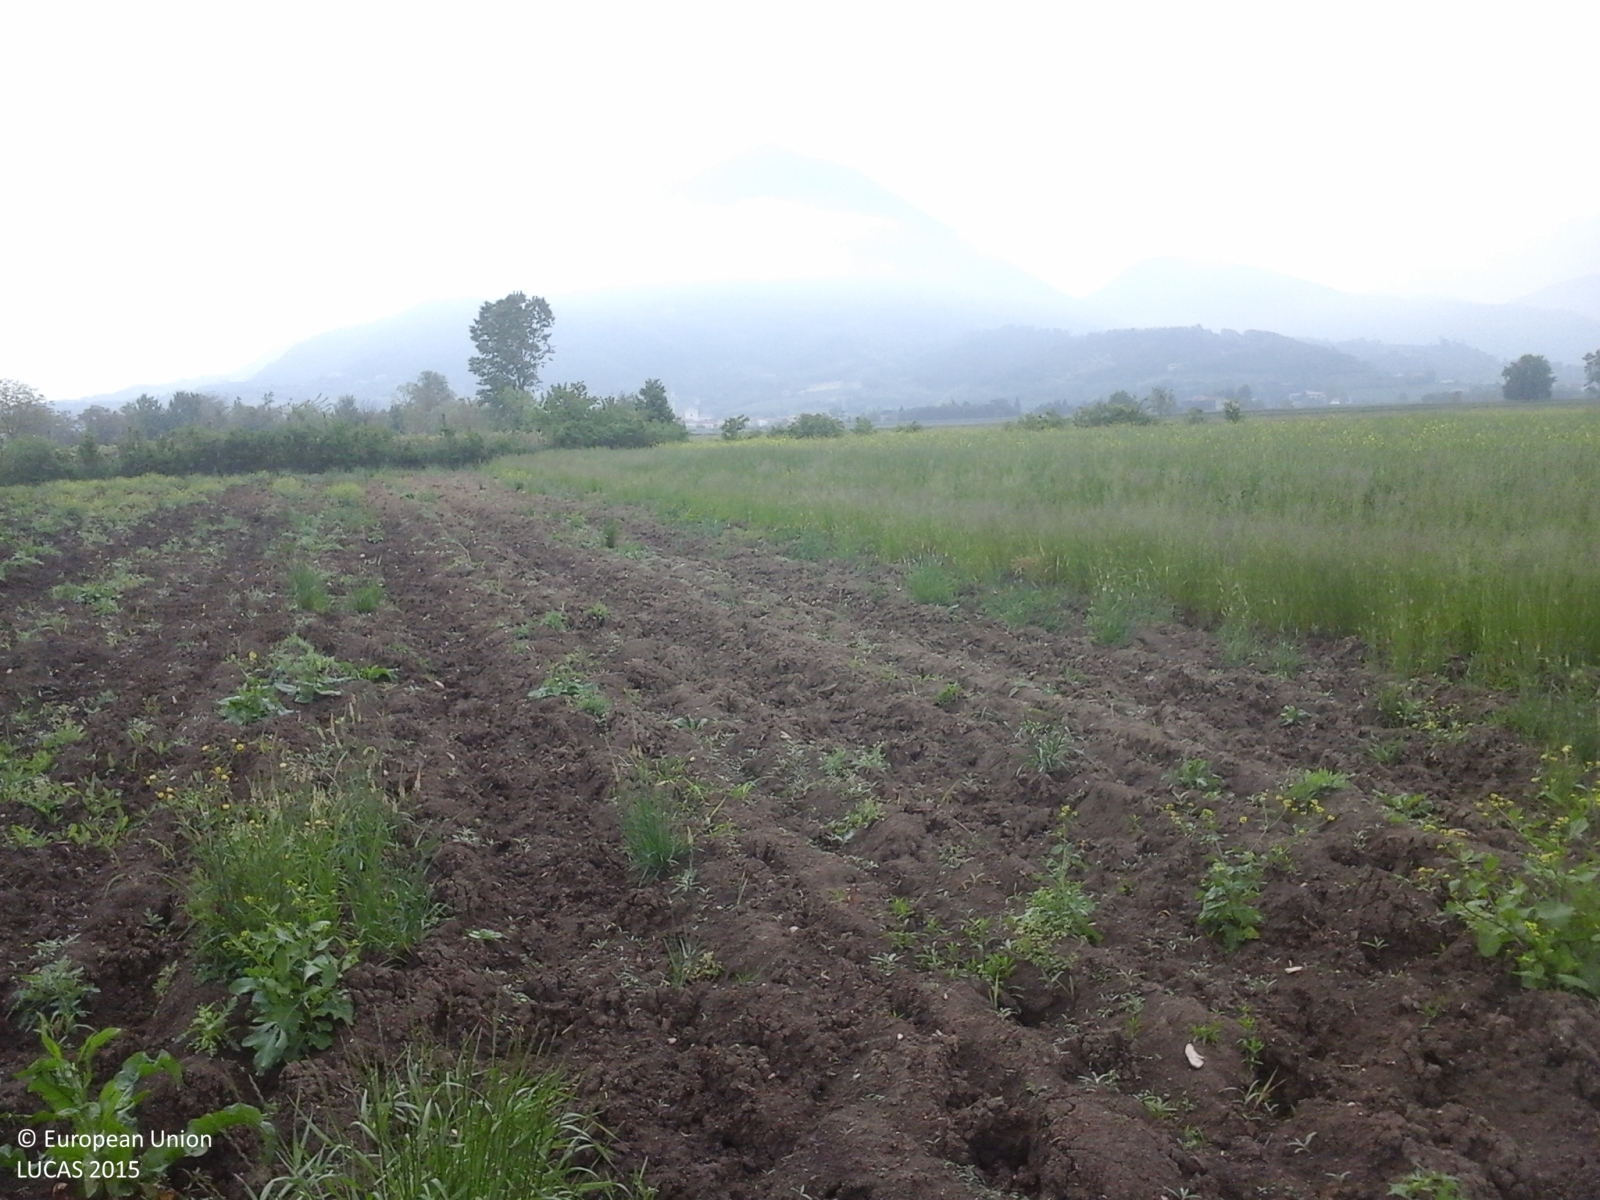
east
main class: Grassland
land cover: Spontaneously vegetated surfaces
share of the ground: 25 - 50 %
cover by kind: consolidated bare surface 80 %, herbaceous plants 20 %
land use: Fallow land
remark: Tilled/Sowed
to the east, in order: Spontaneously vegetated surfaces; Ditches and canals; Grassland with sparse tree/shrub cover; Vineyards; Grassland without tree/shrub cover
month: May
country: IT
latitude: 45.3658
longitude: 11.6187
